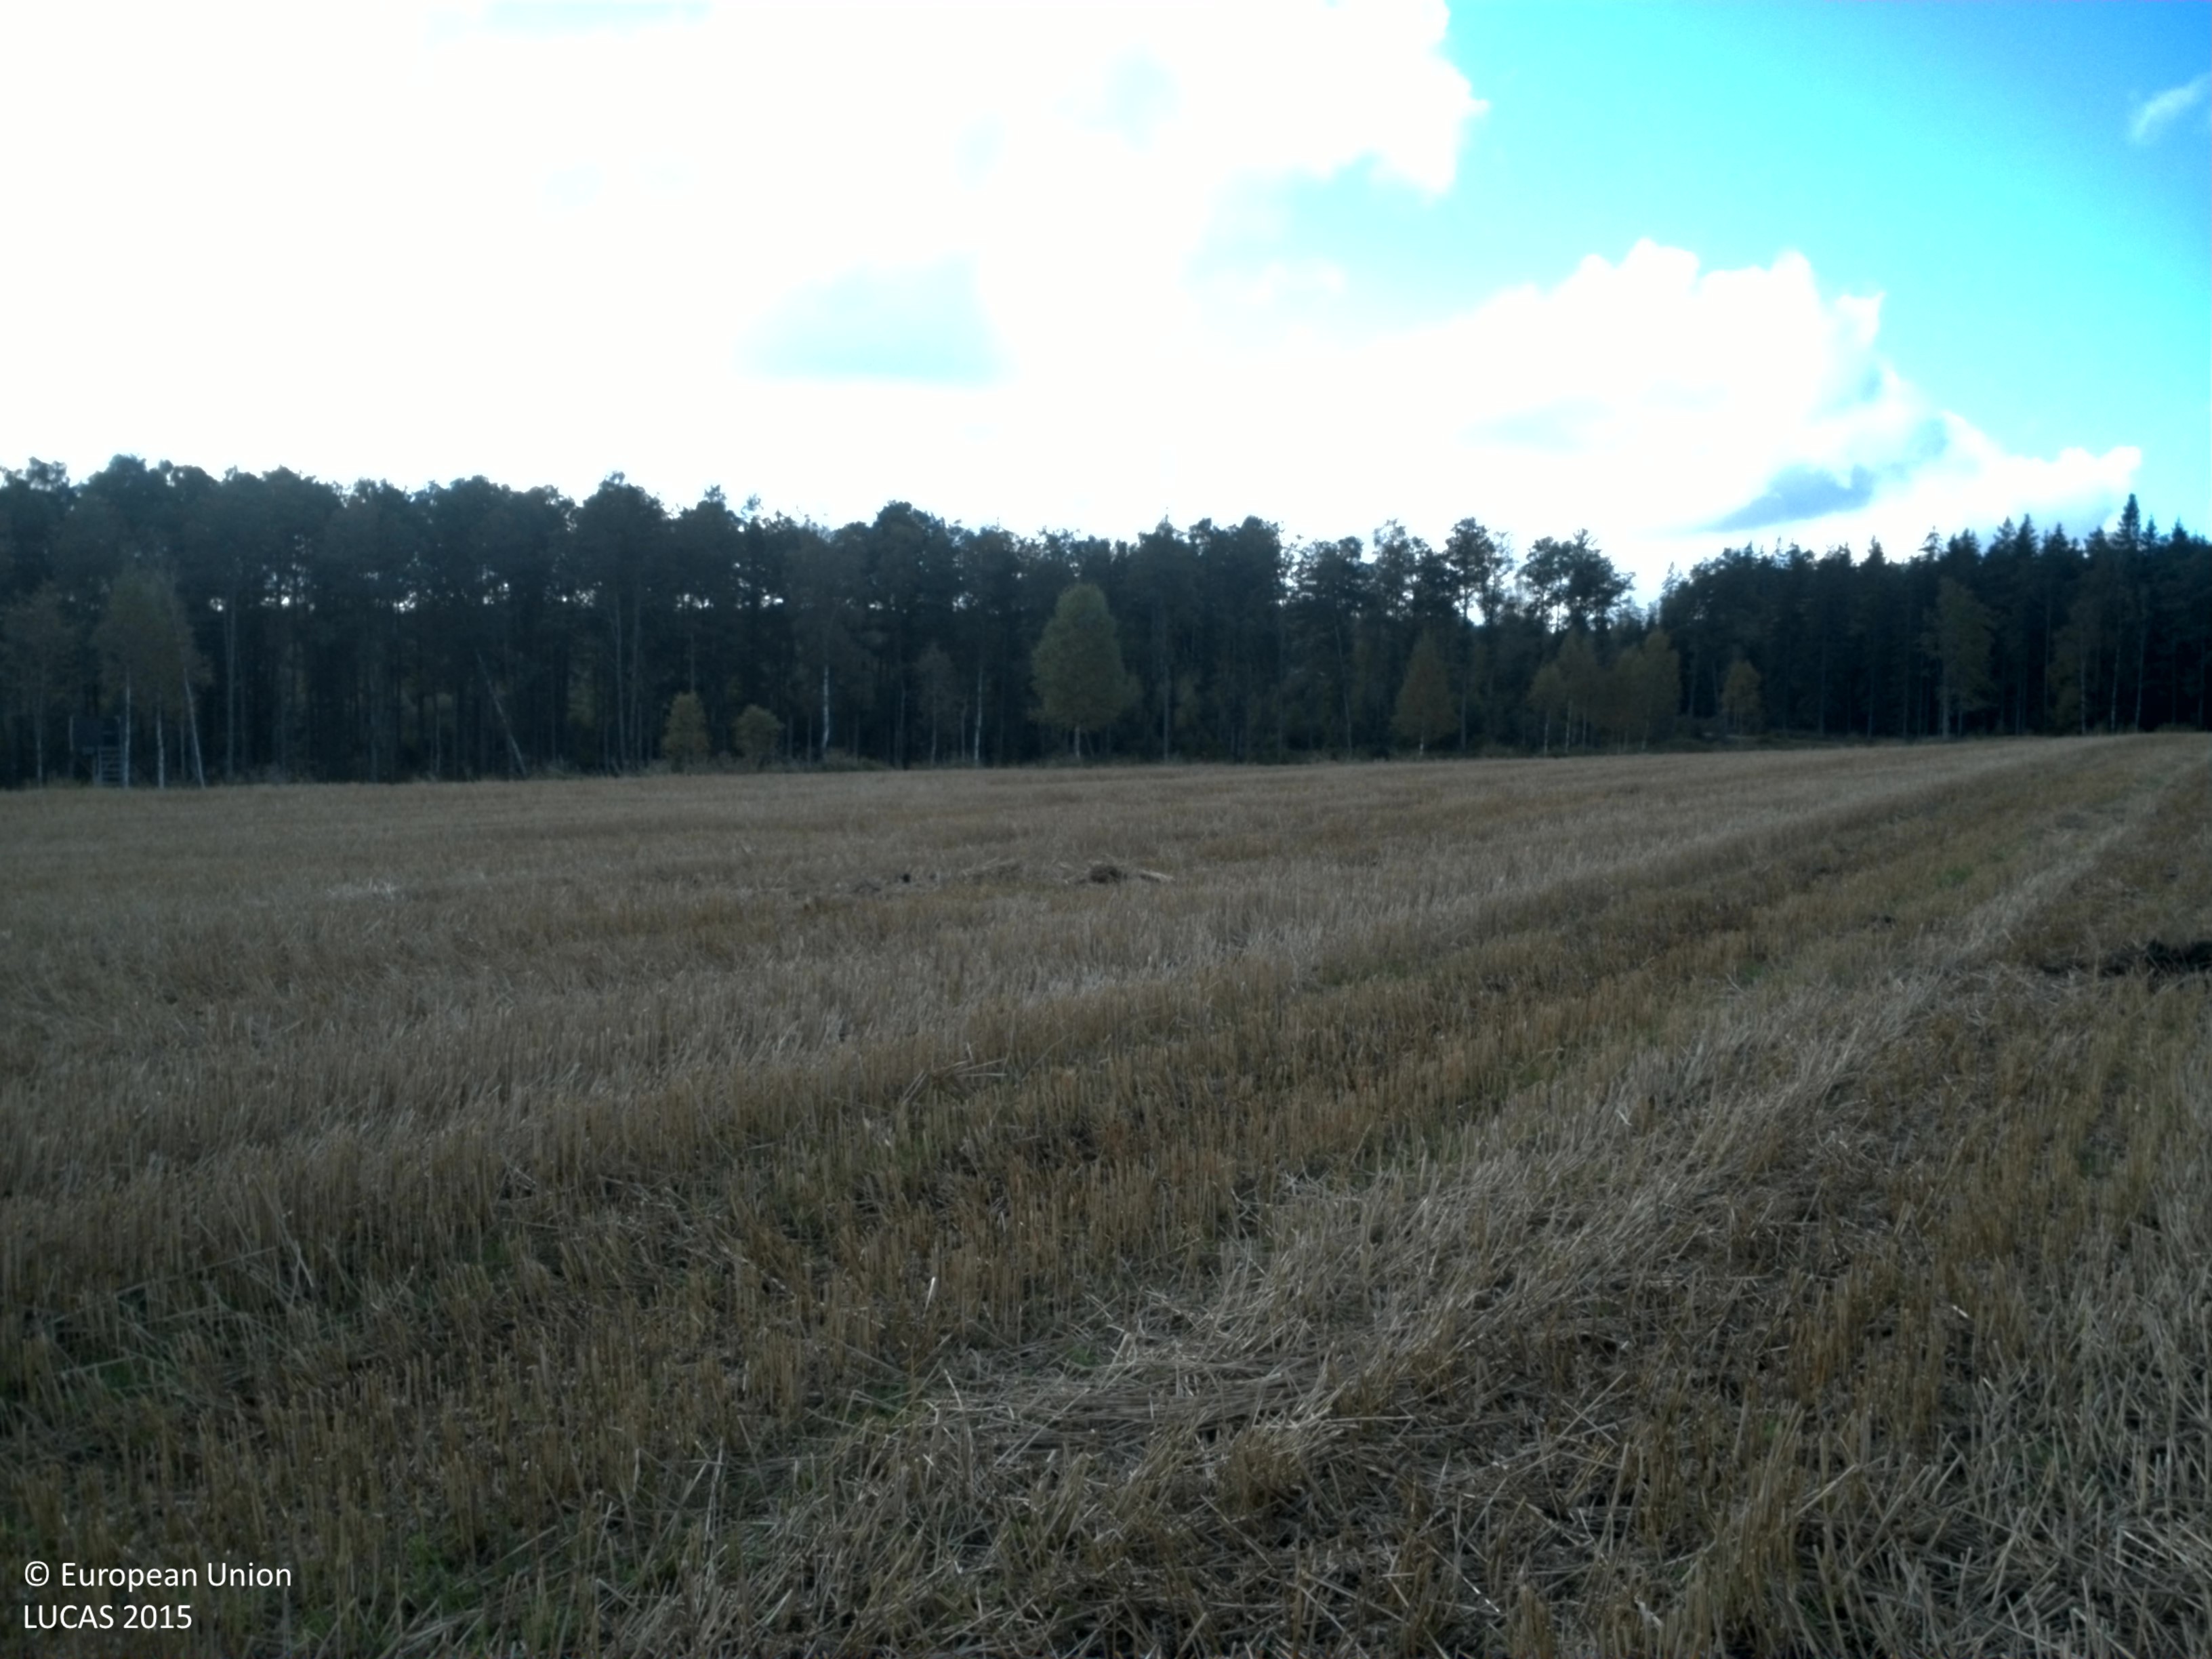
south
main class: Cropland
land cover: Common wheat
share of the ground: 50 - 75 %
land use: Agriculture (excluding fallow land and kitchen gardens)
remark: Harvested field
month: September
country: SE
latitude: 57.9290
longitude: 13.2202
